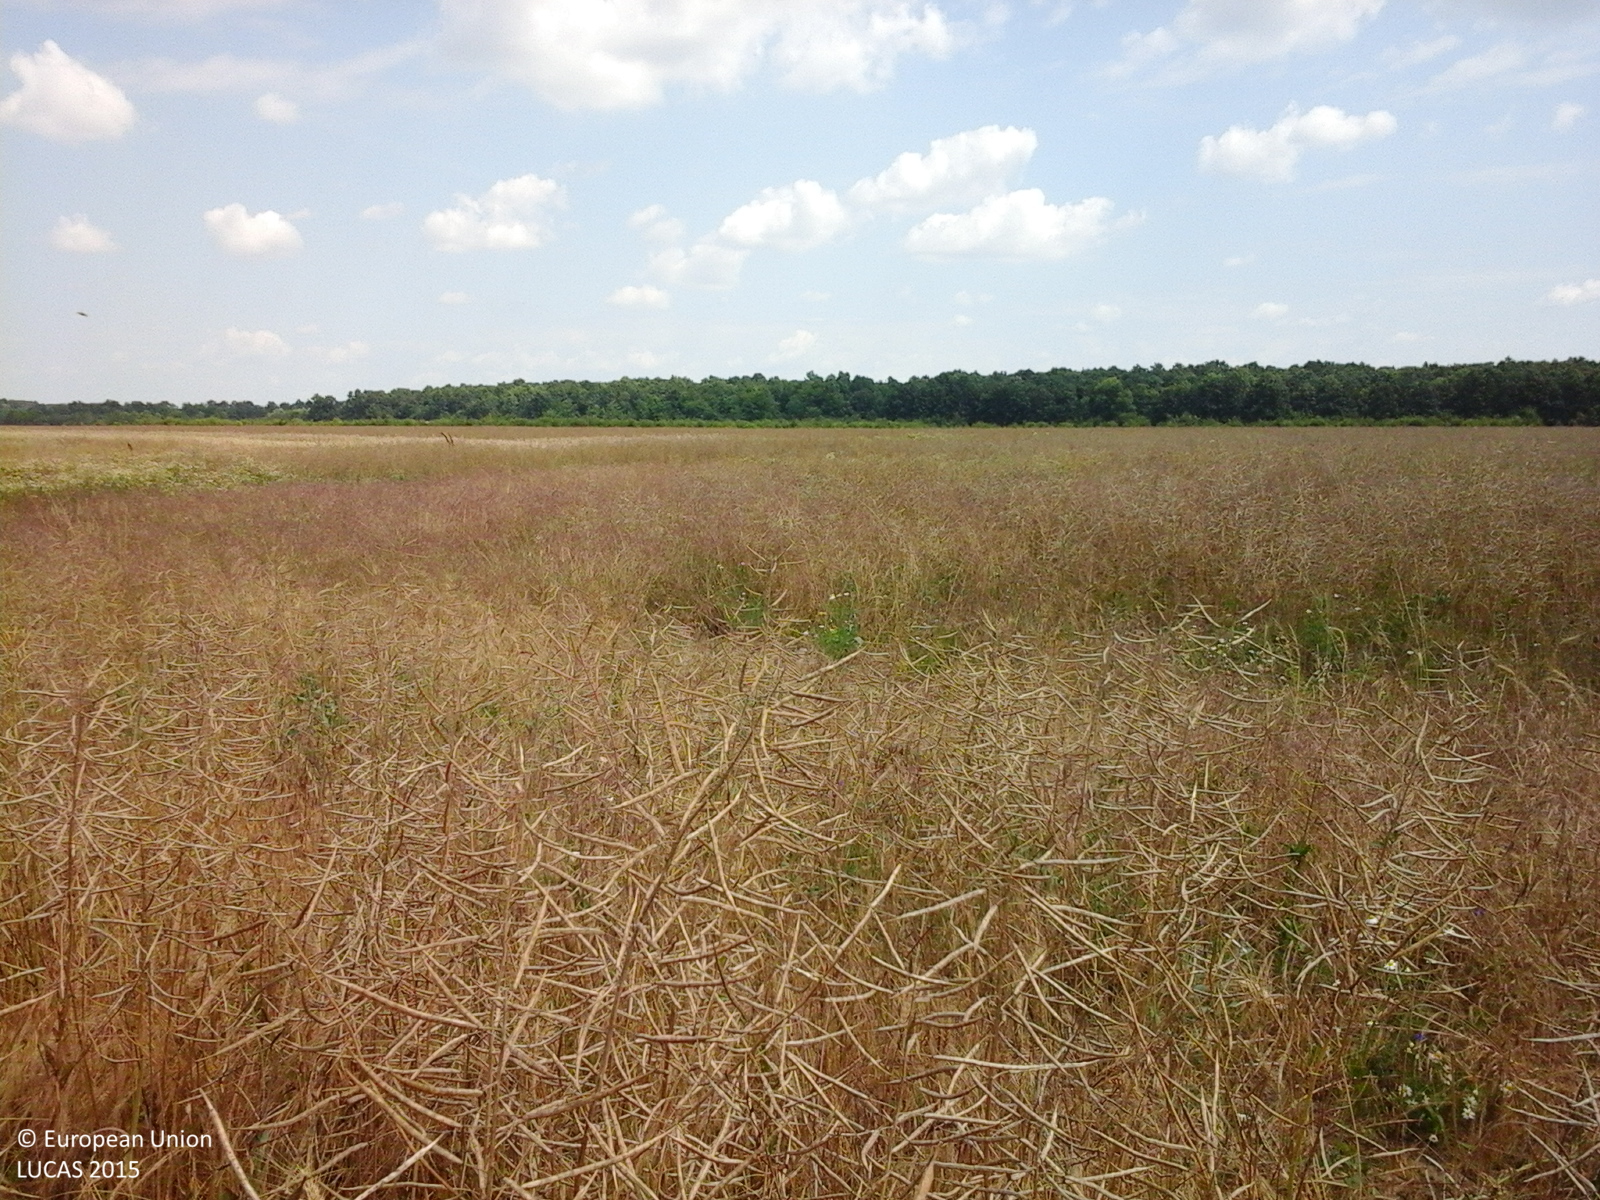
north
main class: Cropland
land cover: Rape and turnip rape
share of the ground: > 75 %
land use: Agriculture (excluding fallow land and kitchen gardens)
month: July
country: RO
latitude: 44.4831
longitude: 25.5967
